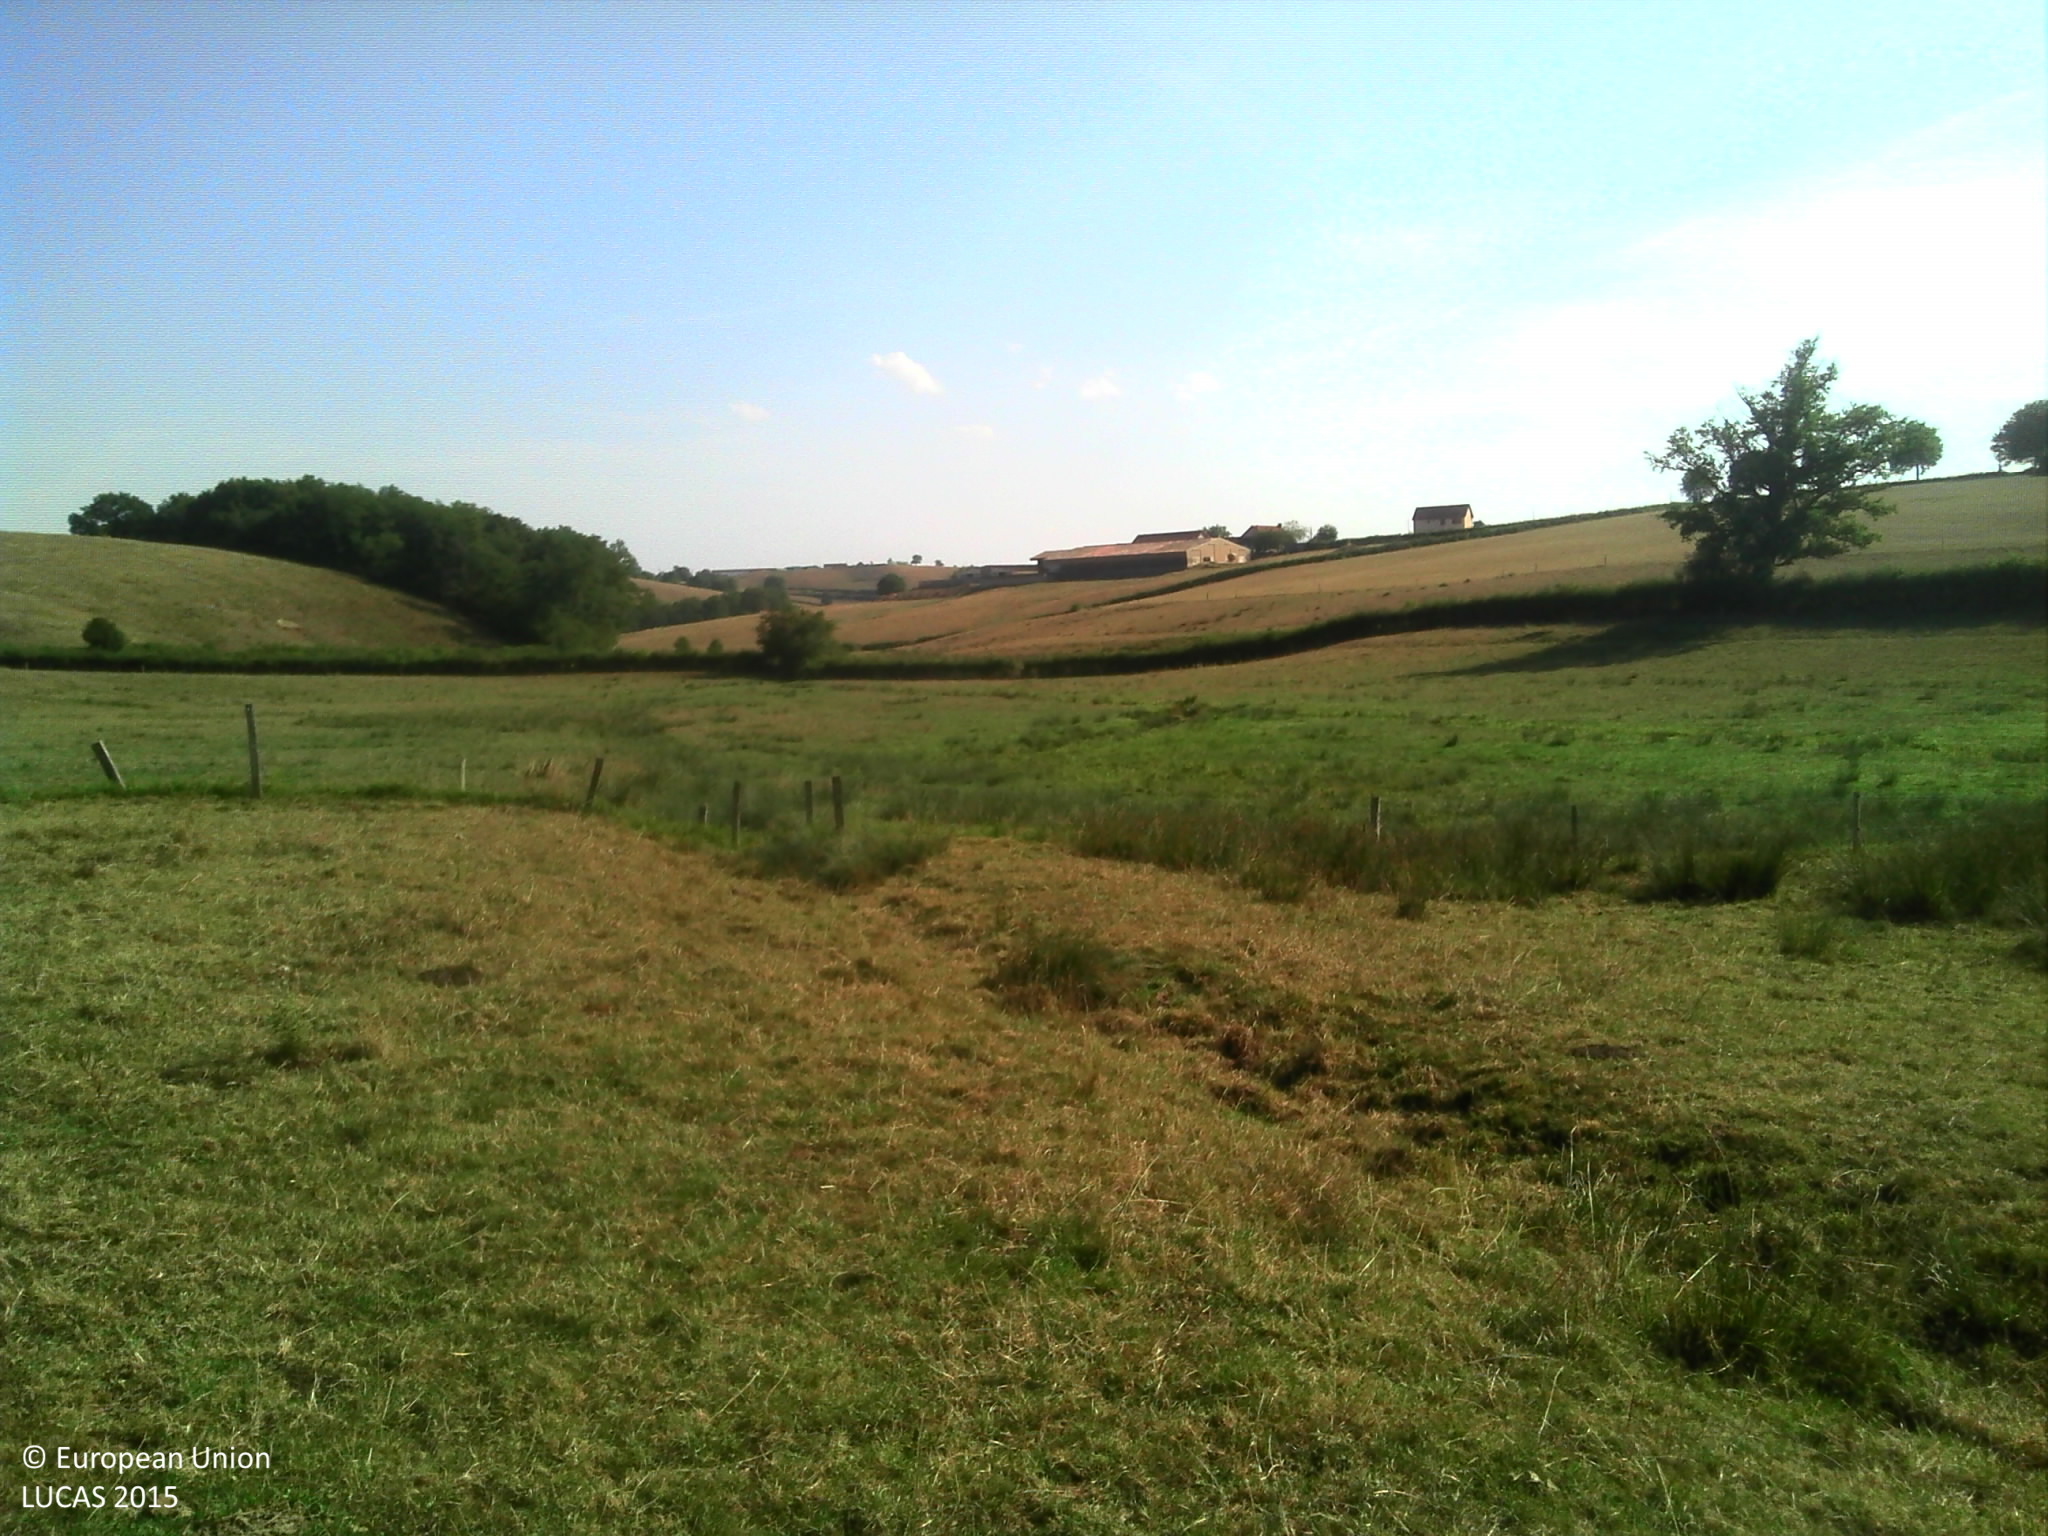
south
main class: Grassland
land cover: Grassland without tree/shrub cover
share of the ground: > 75 %
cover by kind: herbaceous plants 100 %
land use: Agriculture (excluding fallow land and kitchen gardens)
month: August
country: FR
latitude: 46.7798
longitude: 4.3553
